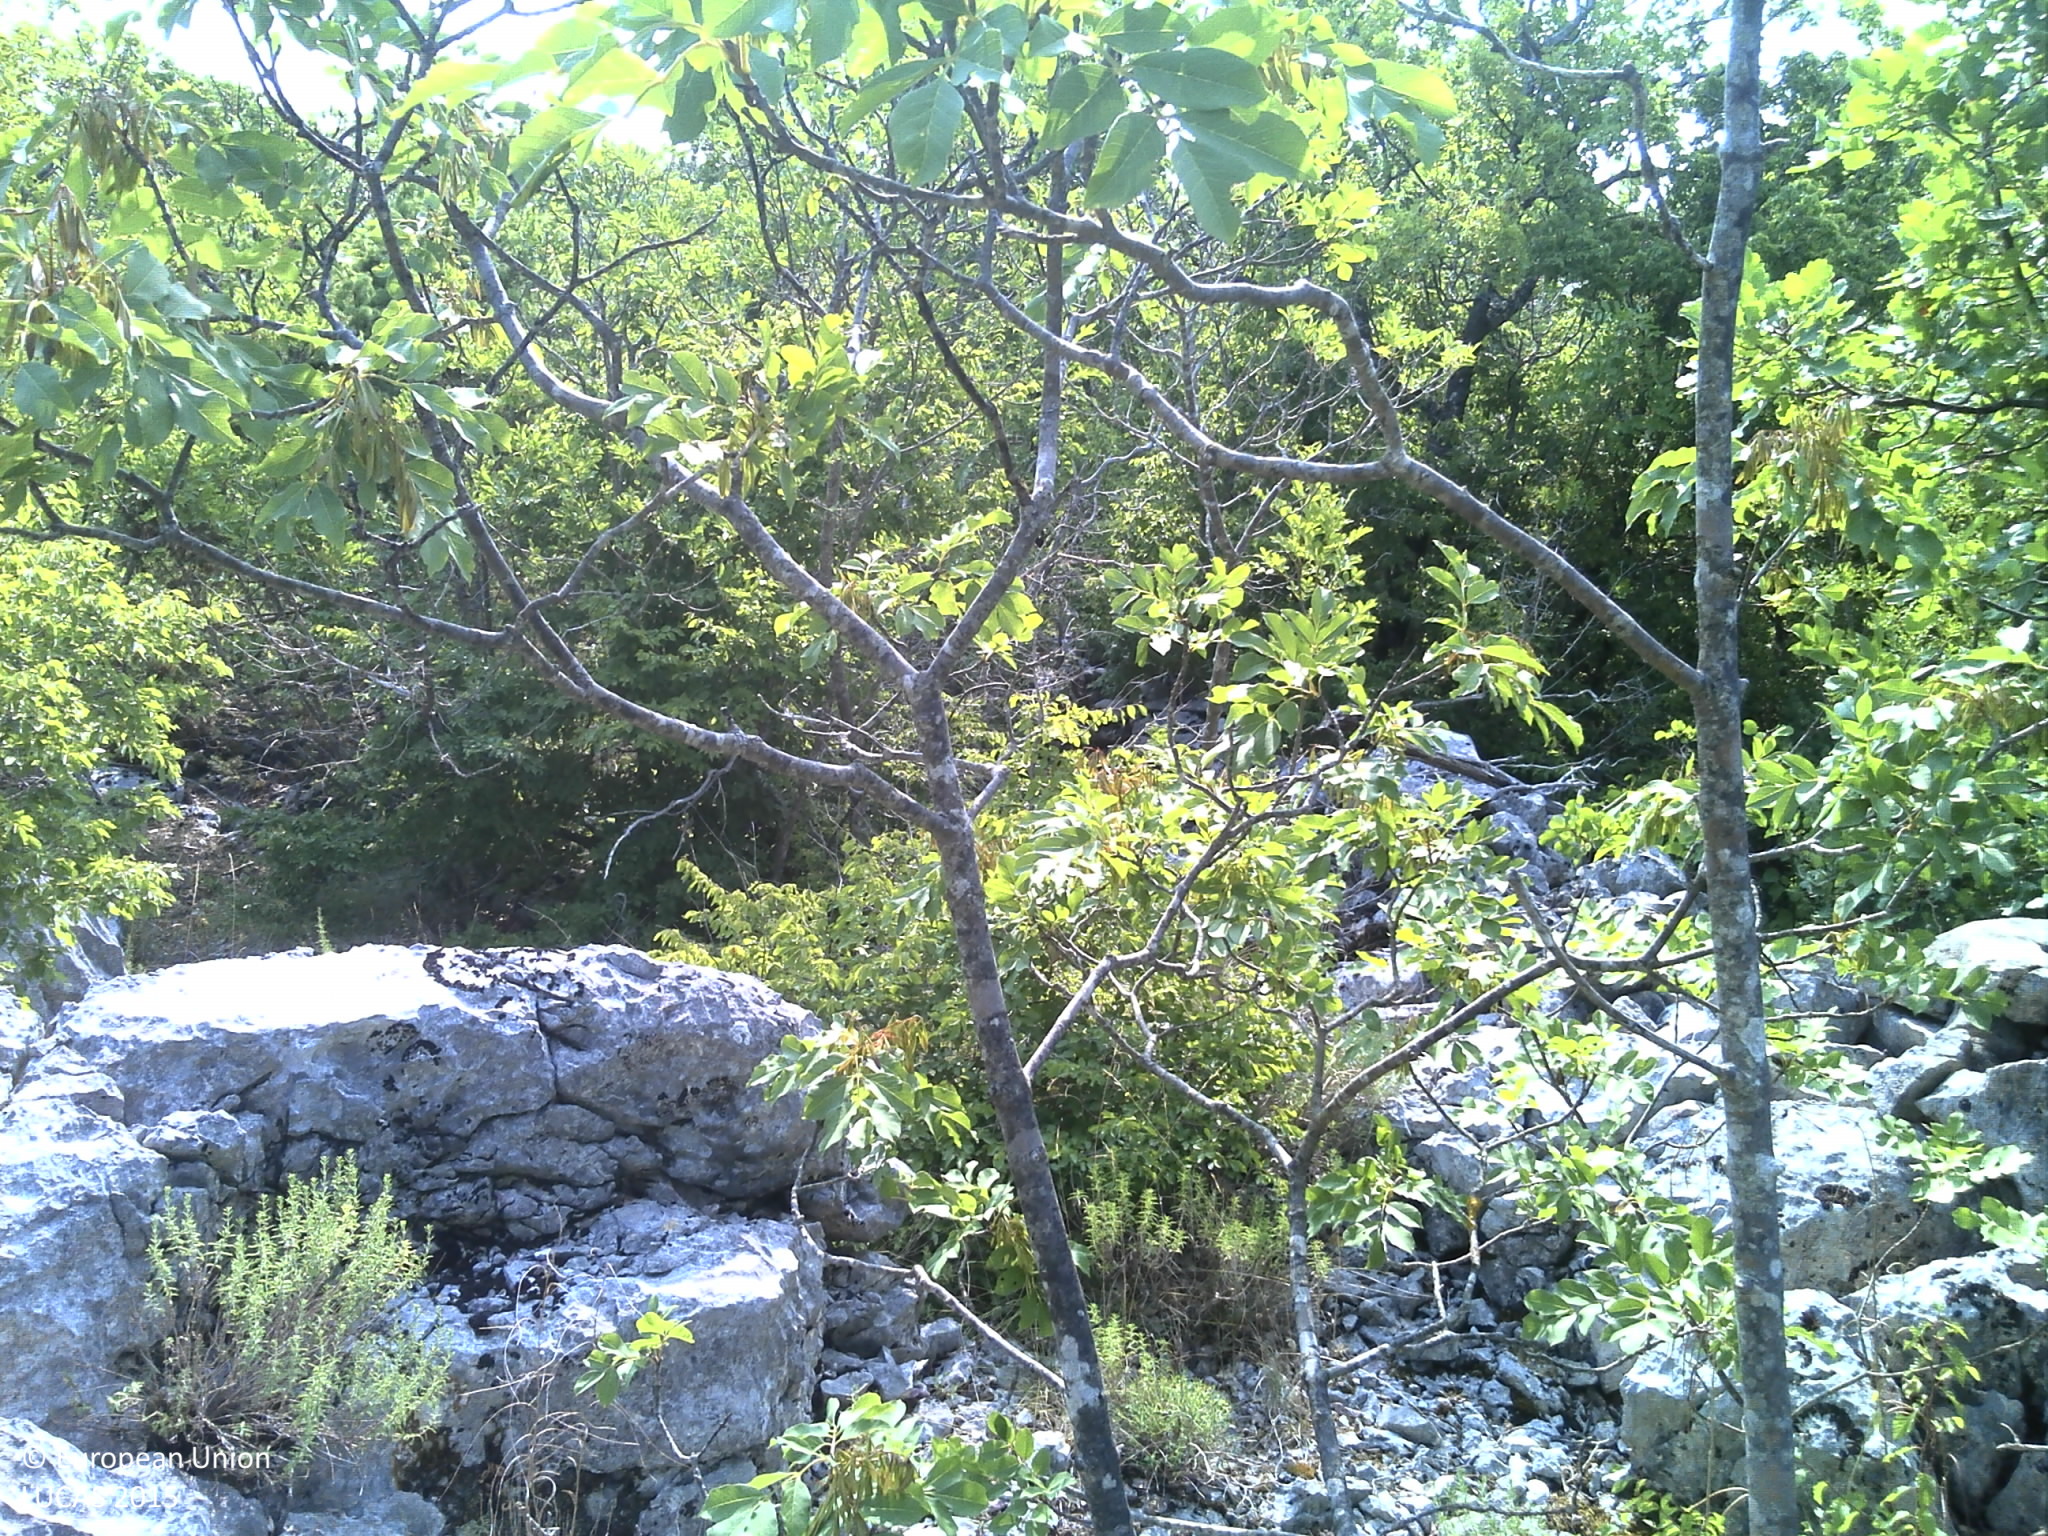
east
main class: Woodland
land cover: Other mixed woodland
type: thermophilous deciduous forest
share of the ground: > 75 %
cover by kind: broadleaved forest trees 45 %, coniferous forest trees 30 %, shrubs 10 %, consolidated bare surface 10 %, herbaceous plants 5 %
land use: Semi-natural and natural areas not in use
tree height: > 5 m
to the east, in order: Other mixed woodland; Dry stone walls; Other mixed woodland; Dry stone walls; Other mixed woodland
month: July
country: HR
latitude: 43.4853
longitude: 16.9280
